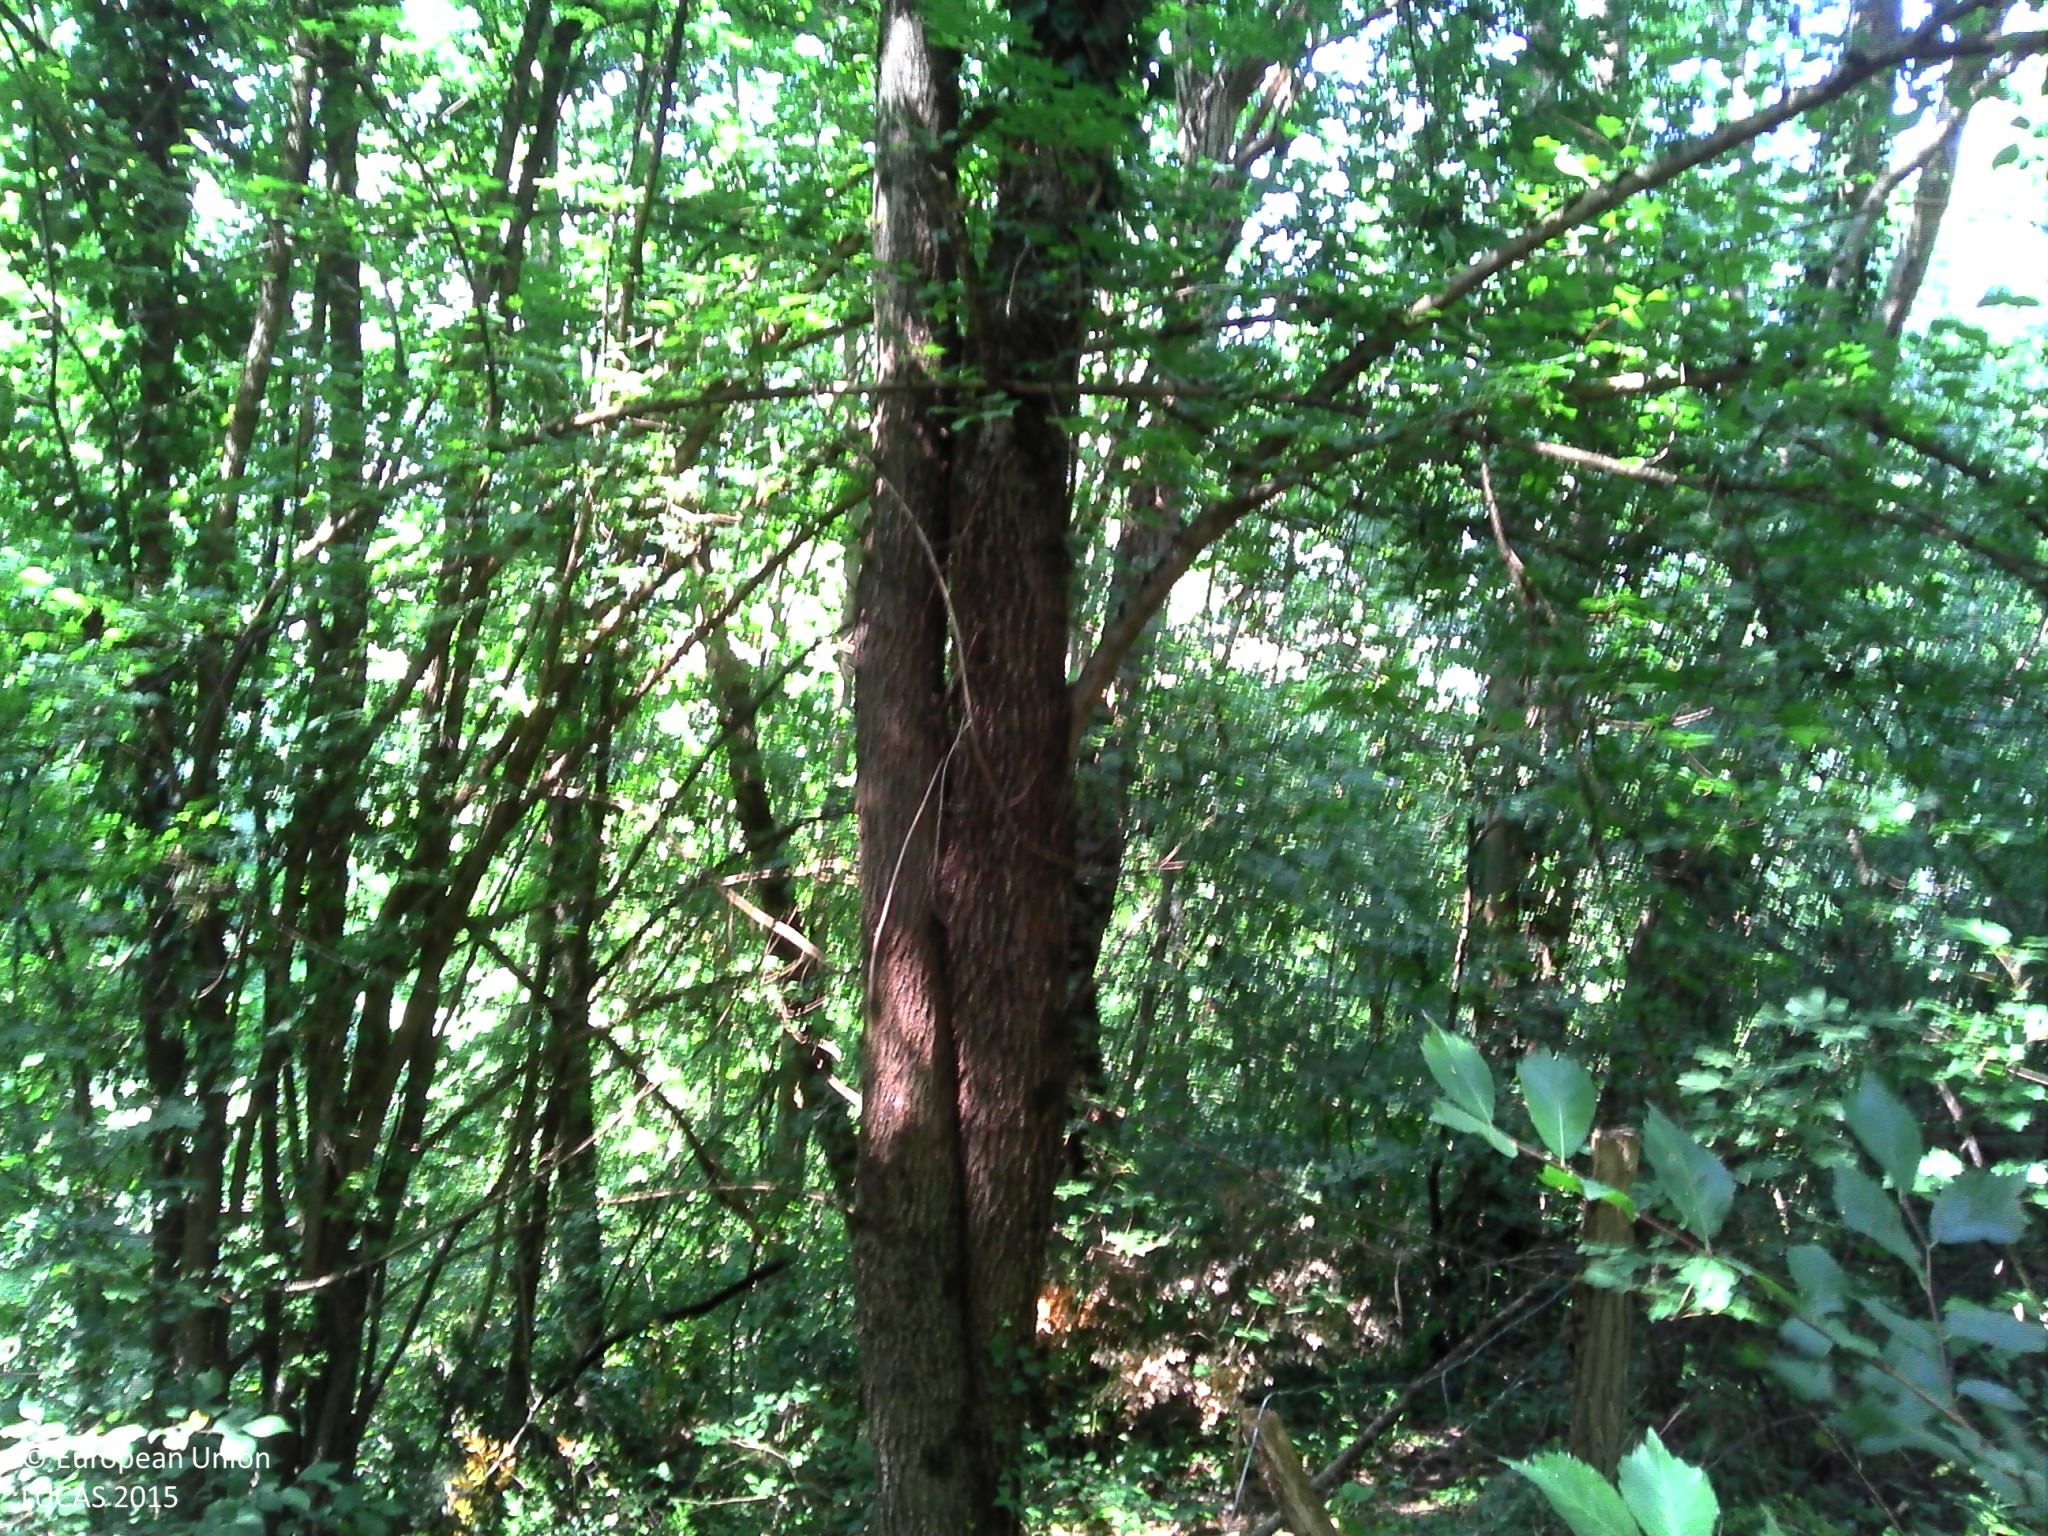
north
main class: Woodland
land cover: Broadleaved woodland
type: mesophytic deciduous forest
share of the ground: > 75 %
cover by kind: broadleaved forest trees 90 %, shrubs 5 %, herbaceous plants 5 %
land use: Semi-natural and natural areas not in use
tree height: > 5 m
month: July
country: FR
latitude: 42.7833
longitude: 1.6838
